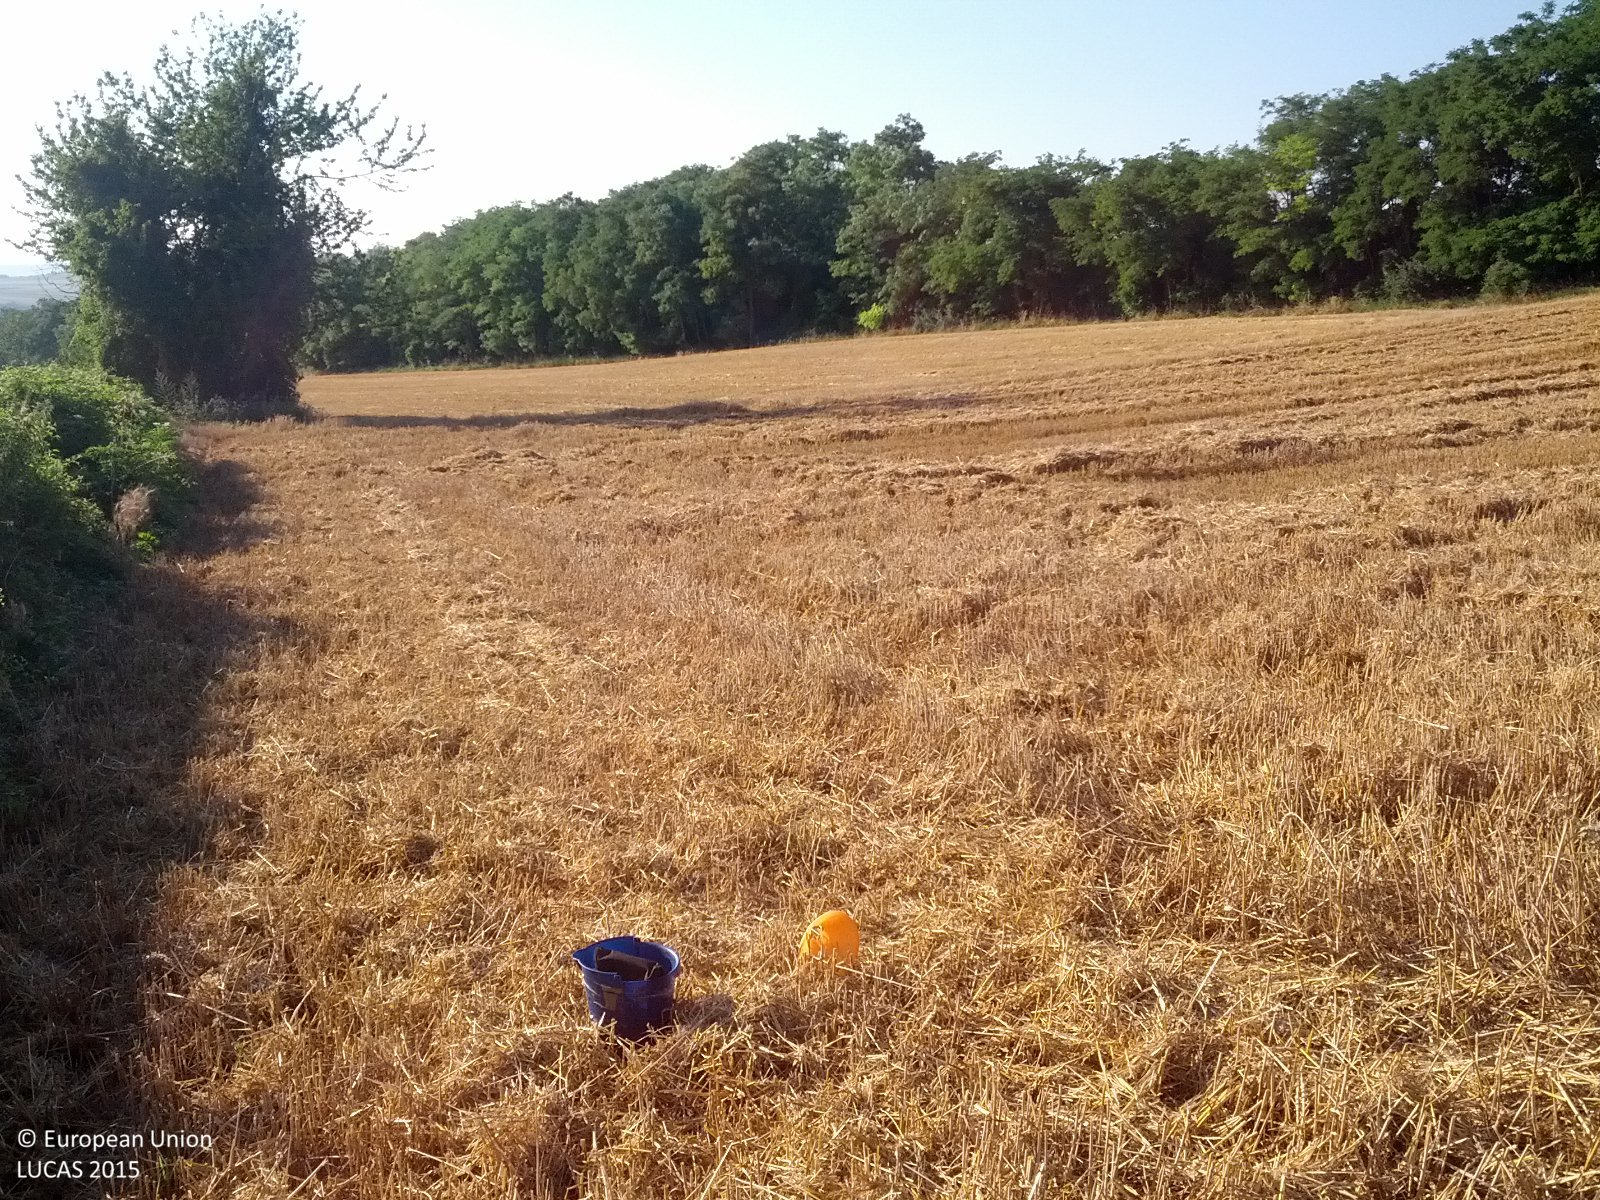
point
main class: Cropland
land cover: Common wheat
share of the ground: < 10 %
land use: Agriculture (excluding fallow land and kitchen gardens)
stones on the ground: < 10 %
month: July
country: AT
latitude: 48.4573
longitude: 16.3202
